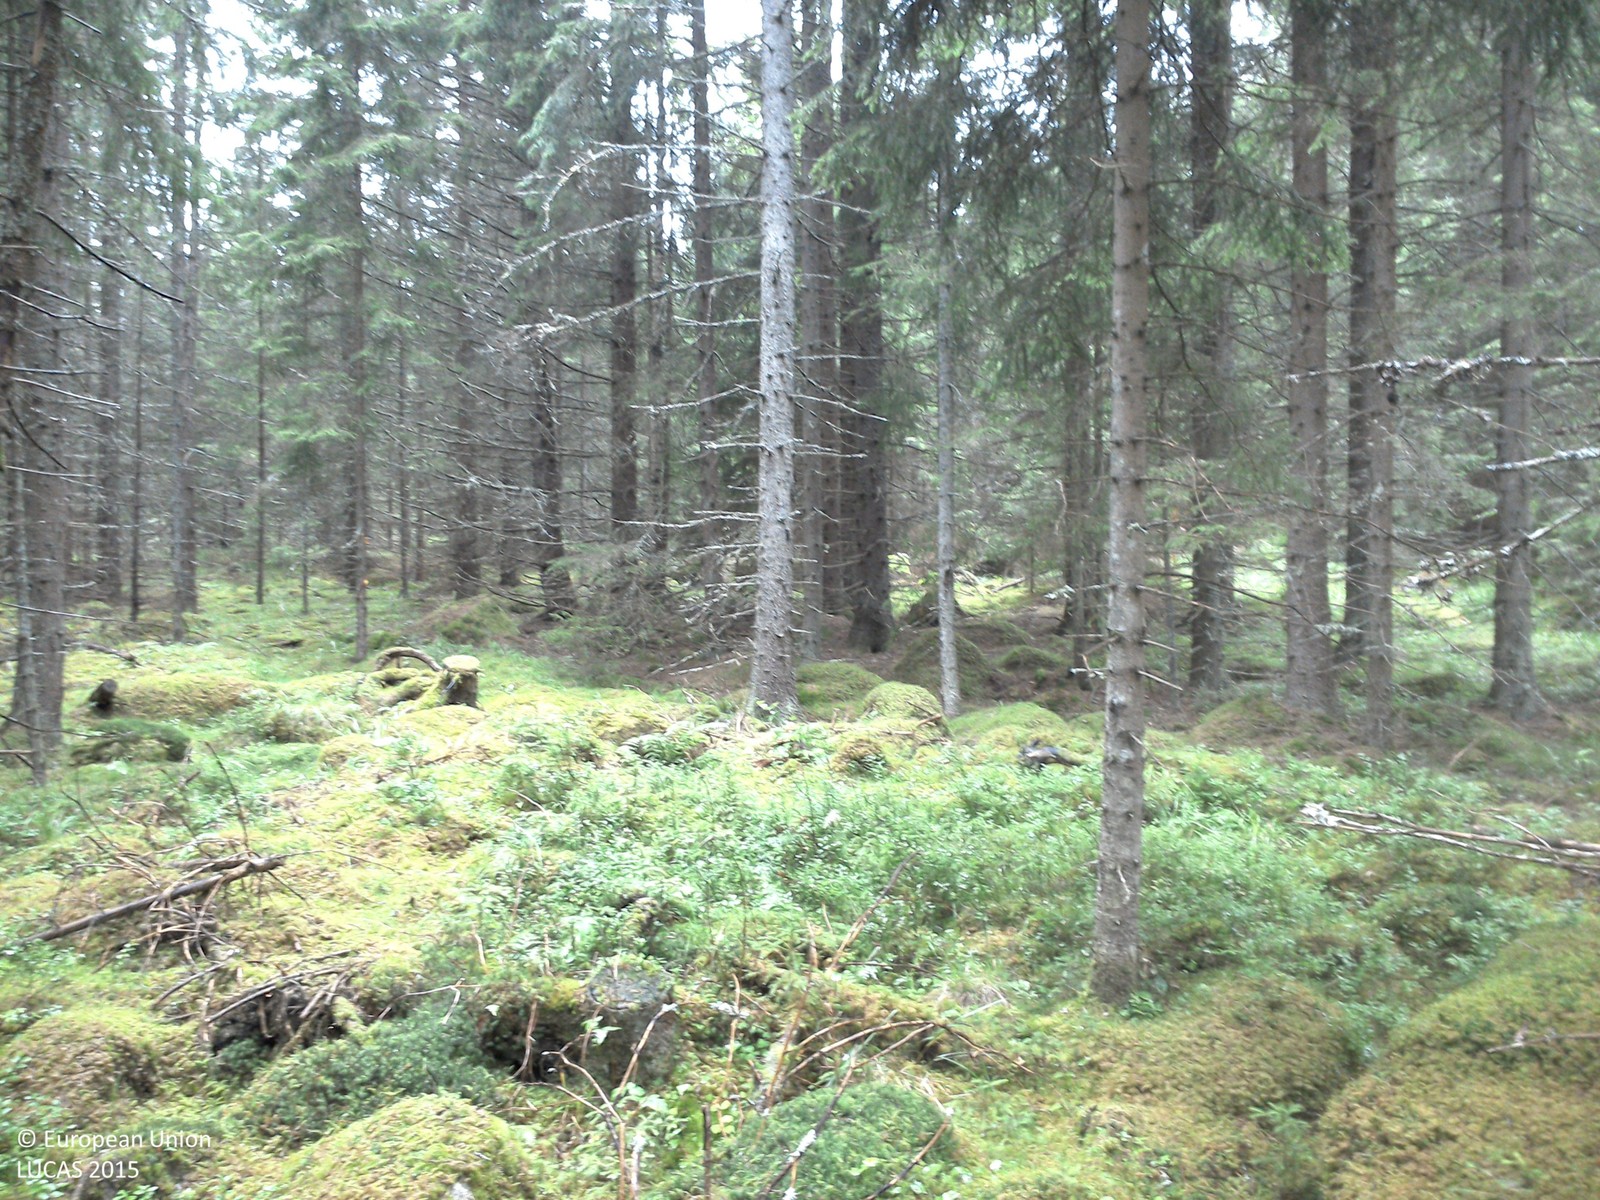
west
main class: Woodland
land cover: Spruce dominated coniferous woodland
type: boreal forest
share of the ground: > 75 %
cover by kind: coniferous forest trees 75 %, lichens and mosses 25 %
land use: Forestry
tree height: > 5 m
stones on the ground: < 10 %
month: July
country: SE
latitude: 57.8162
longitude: 15.9726
